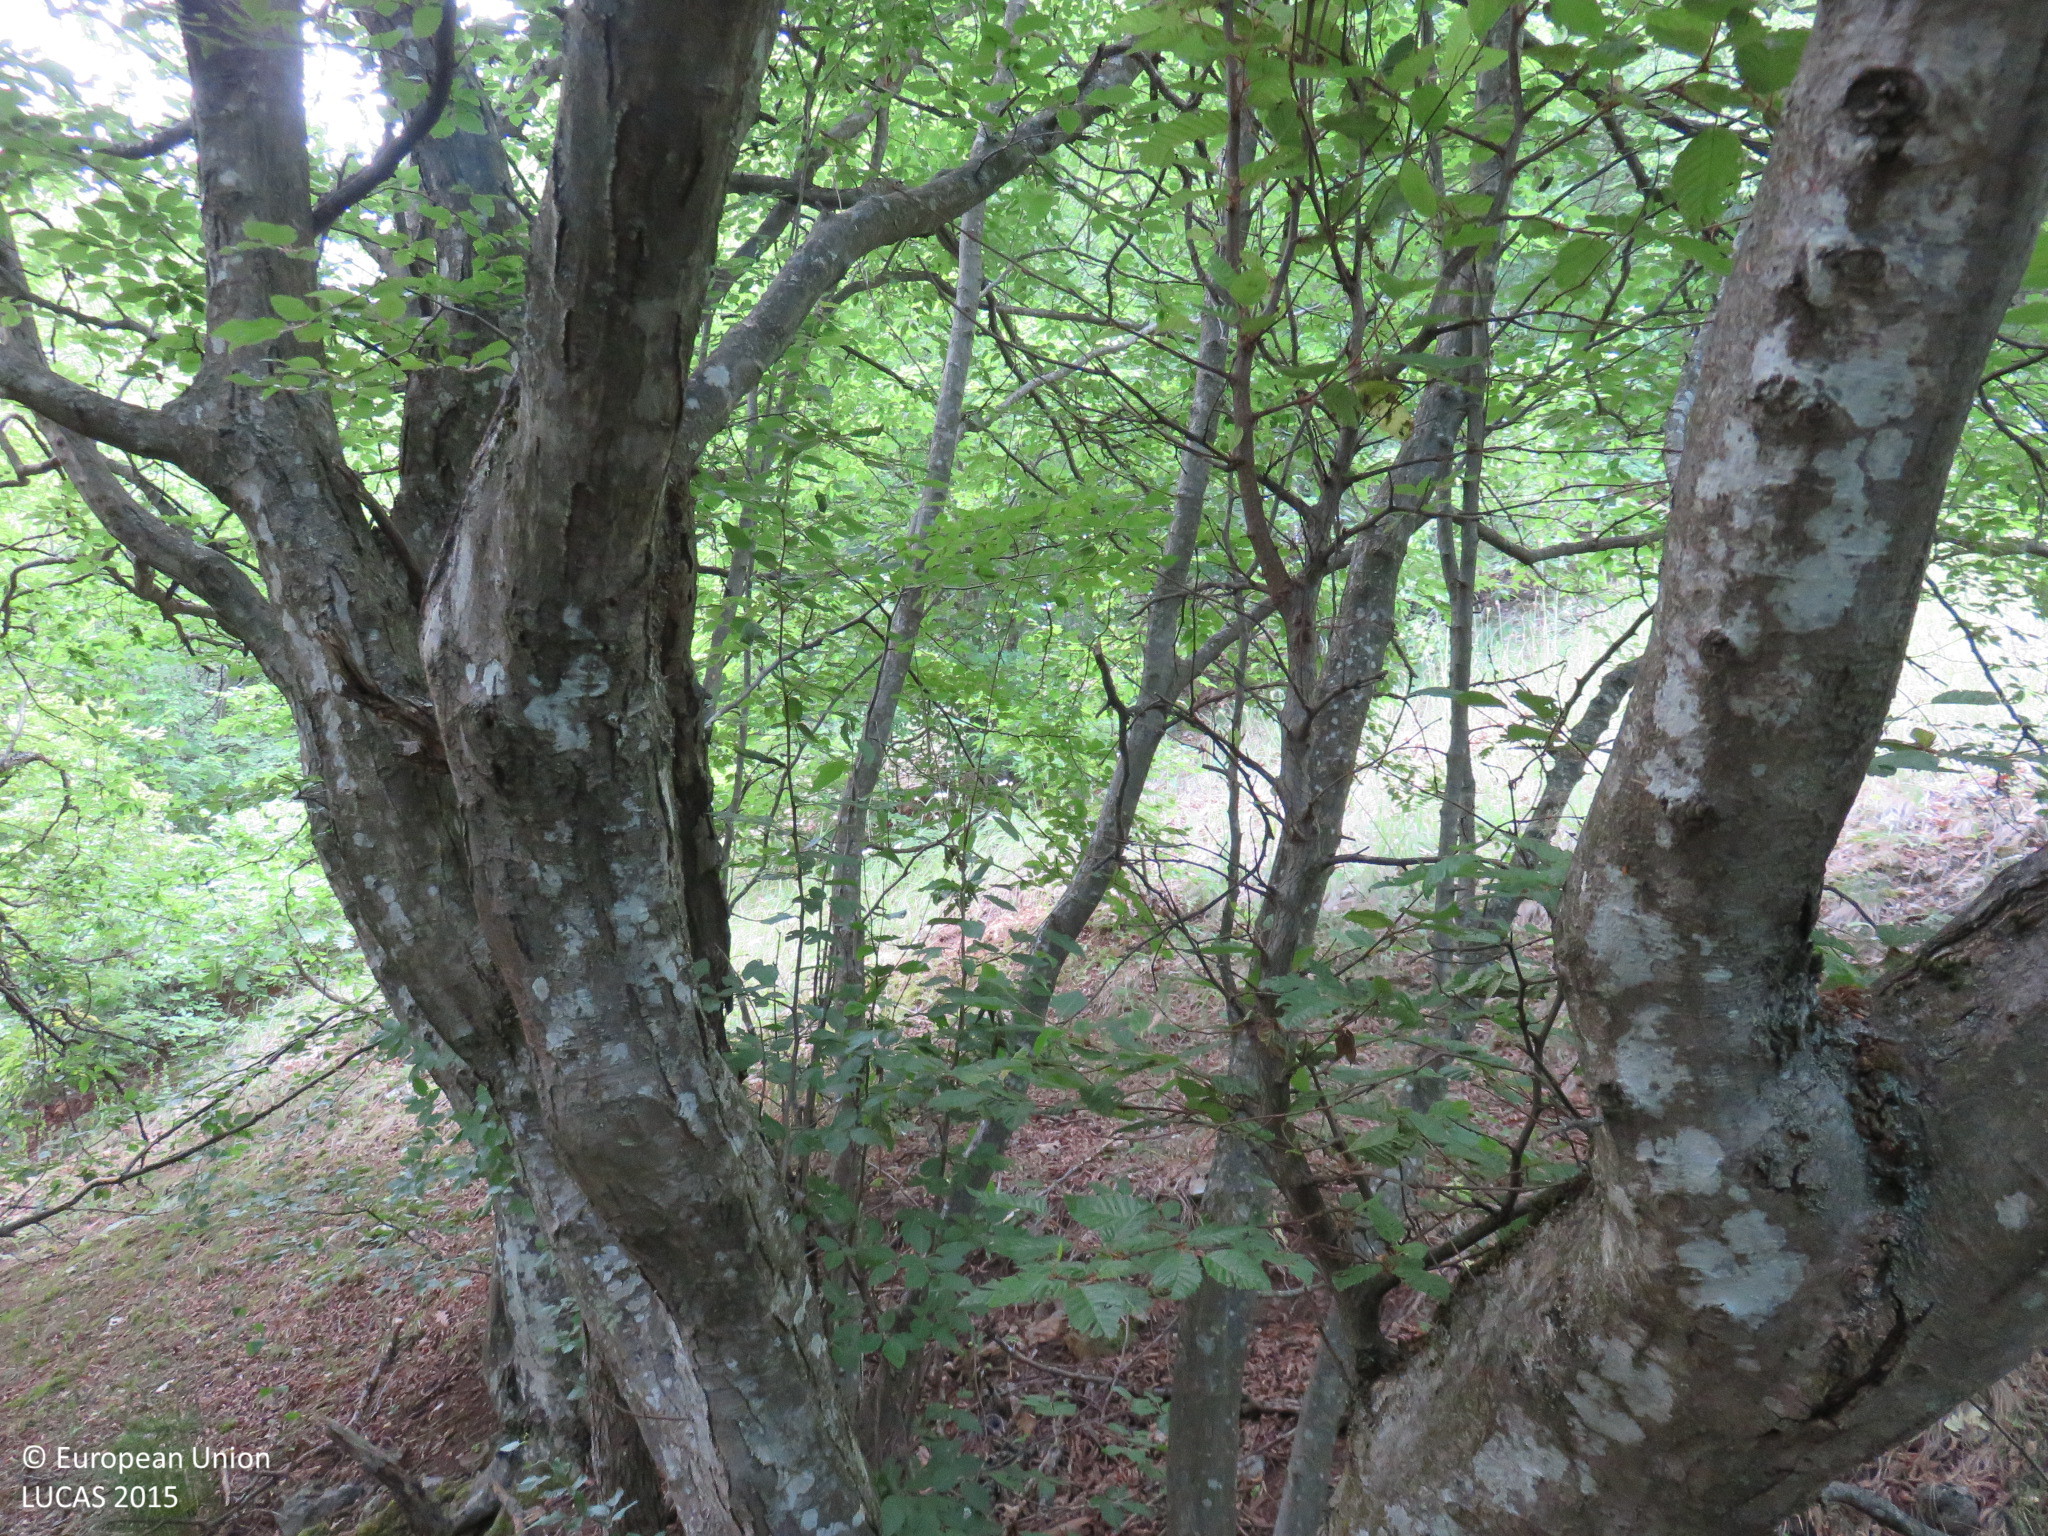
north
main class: Woodland
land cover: Broadleaved woodland
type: mesophytic deciduous forest
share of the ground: > 75 %
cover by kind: broadleaved forest trees 80 %, herbaceous plants 20 %
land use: Forestry
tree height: > 5 m
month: June
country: BG
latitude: 43.2338
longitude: 24.5027
